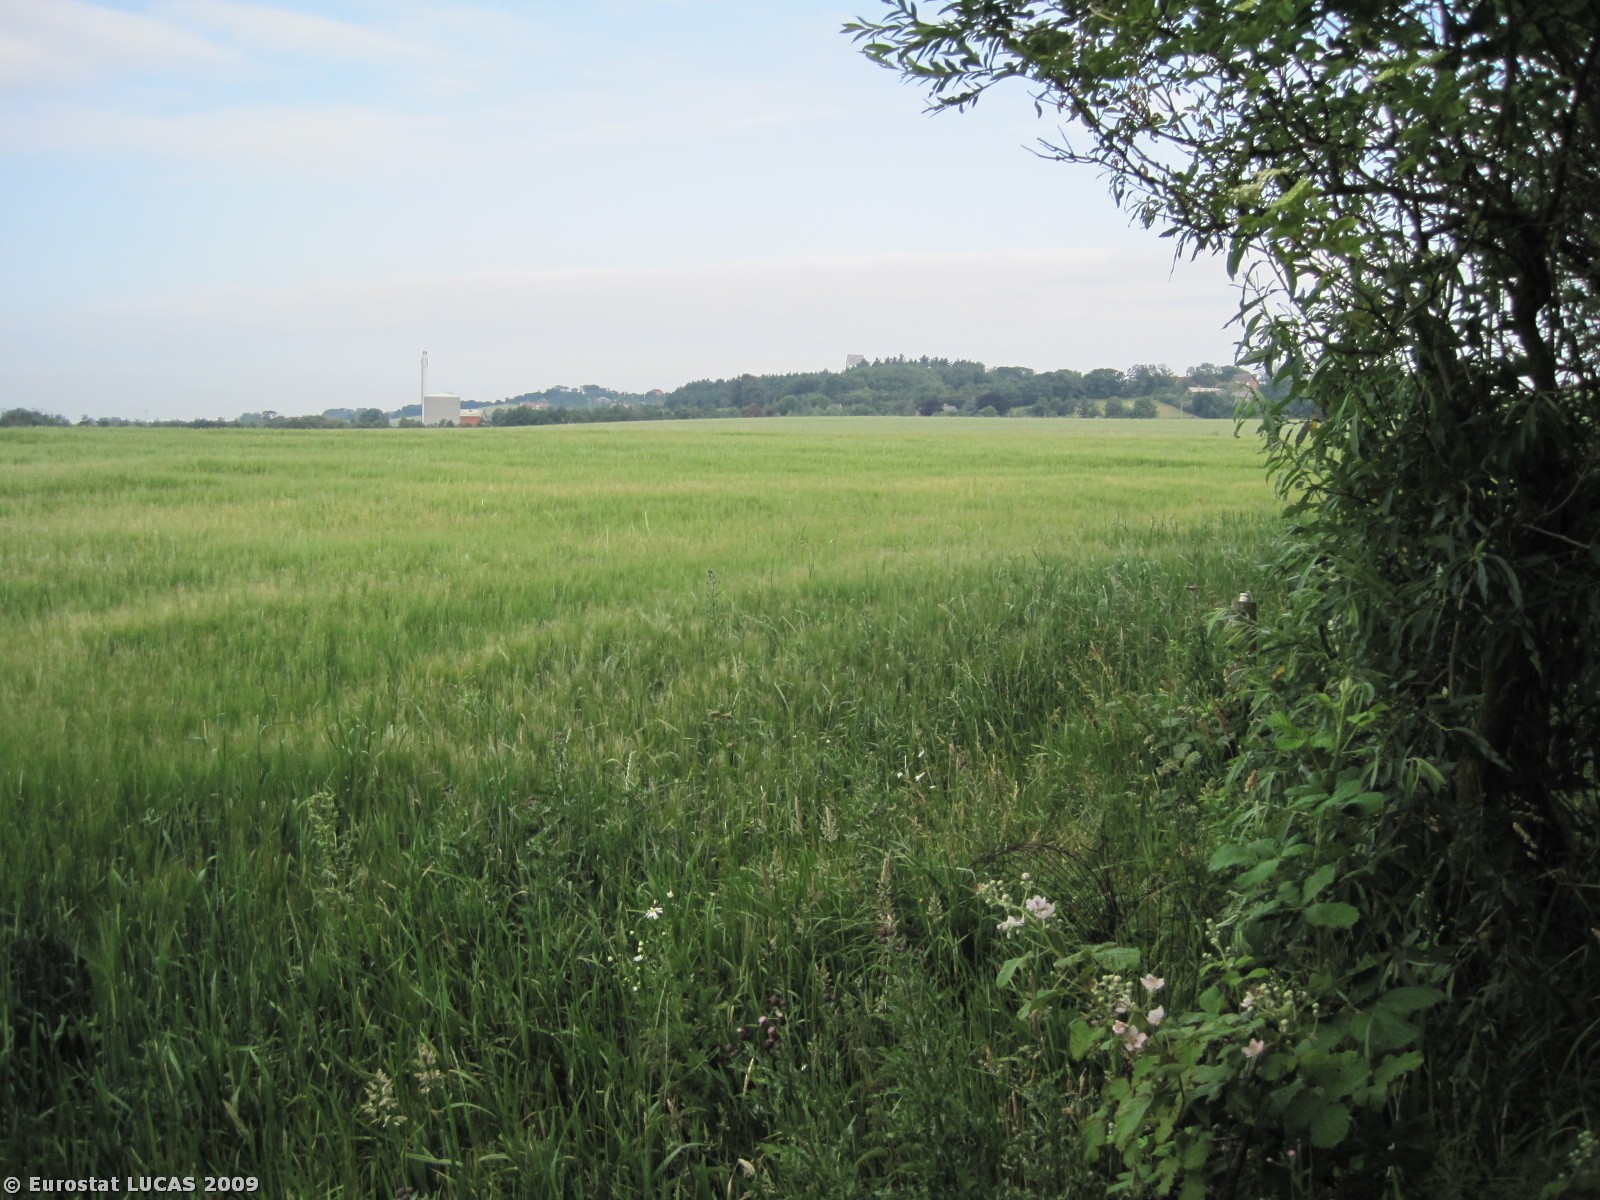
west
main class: Woodland
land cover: Mixed woodland
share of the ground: 50 - 75 %
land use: Residential
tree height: > 5 m
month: June
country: DK
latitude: 56.5557
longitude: 8.4239
